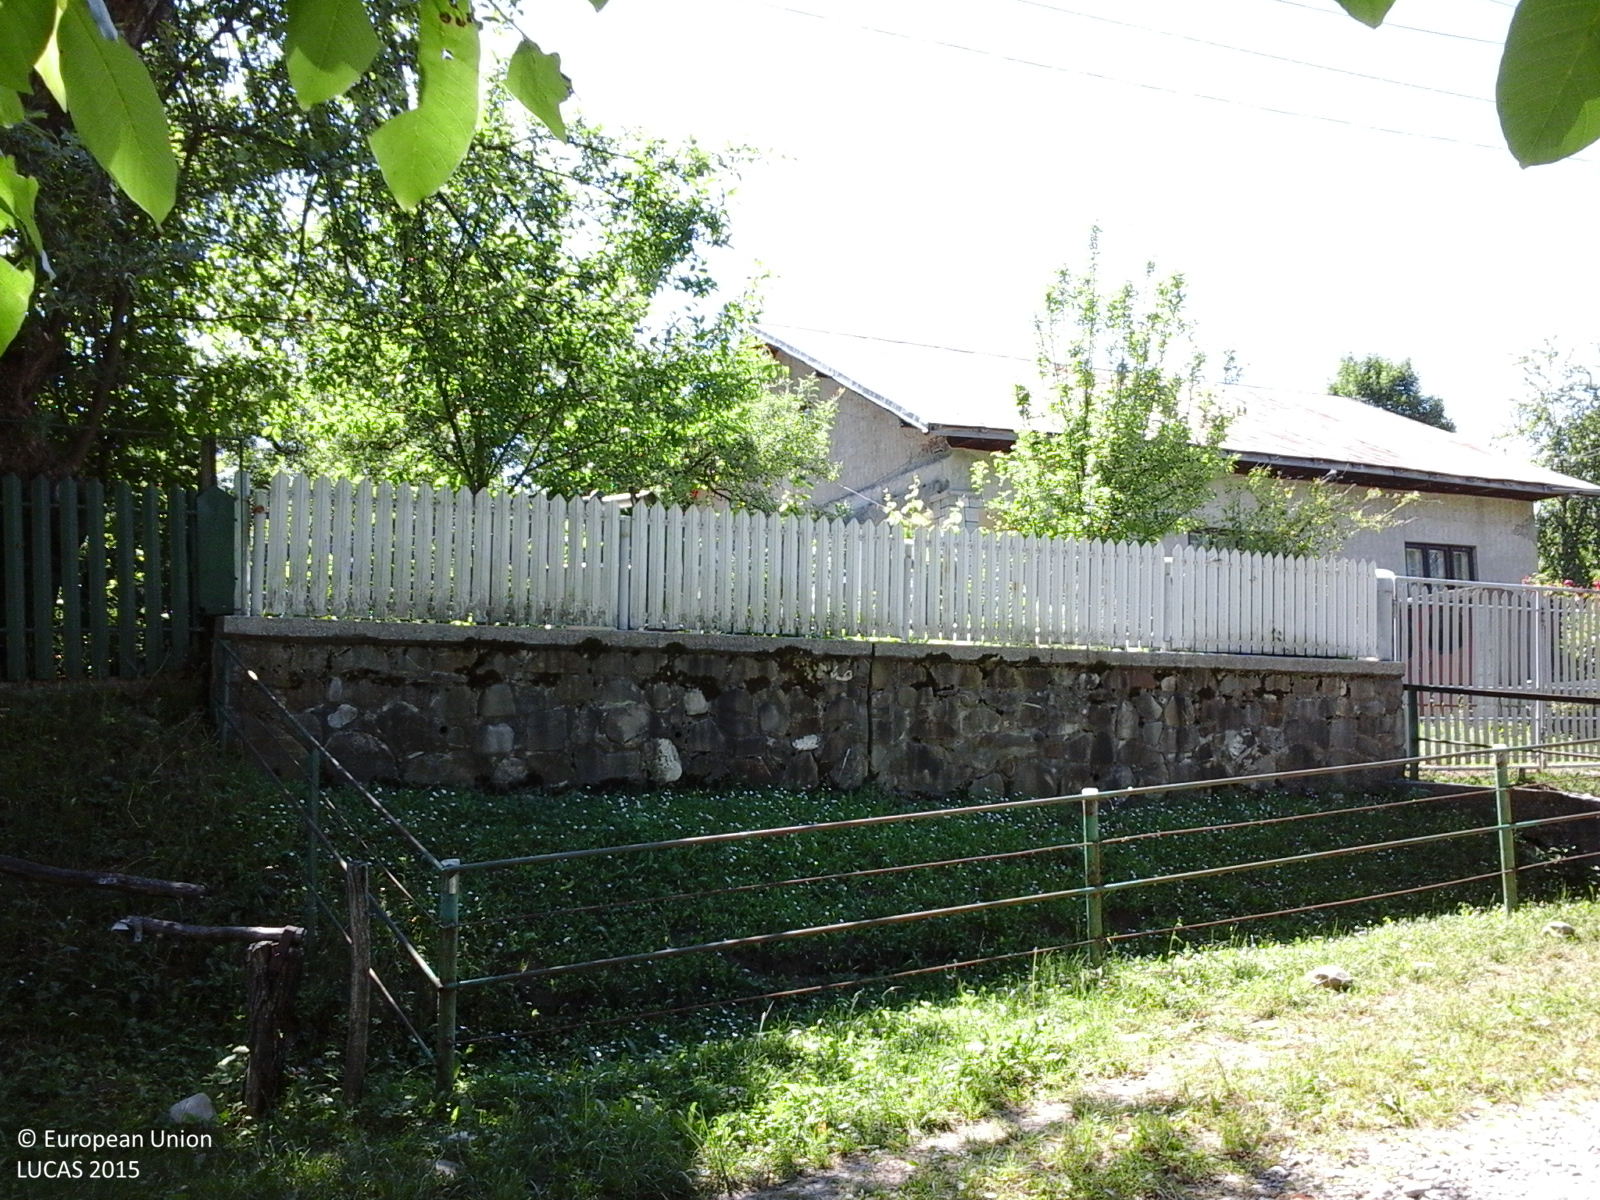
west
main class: Grassland
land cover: Grassland with sparse tree/shrub cover
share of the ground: > 75 %
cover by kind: herbaceous plants 85 %, shrubs 10 %, broadleaved forest trees 5 %
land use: Agriculture (excluding fallow land and kitchen gardens)
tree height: > 5 m
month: June
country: RO
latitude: 45.1900
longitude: 25.7727
